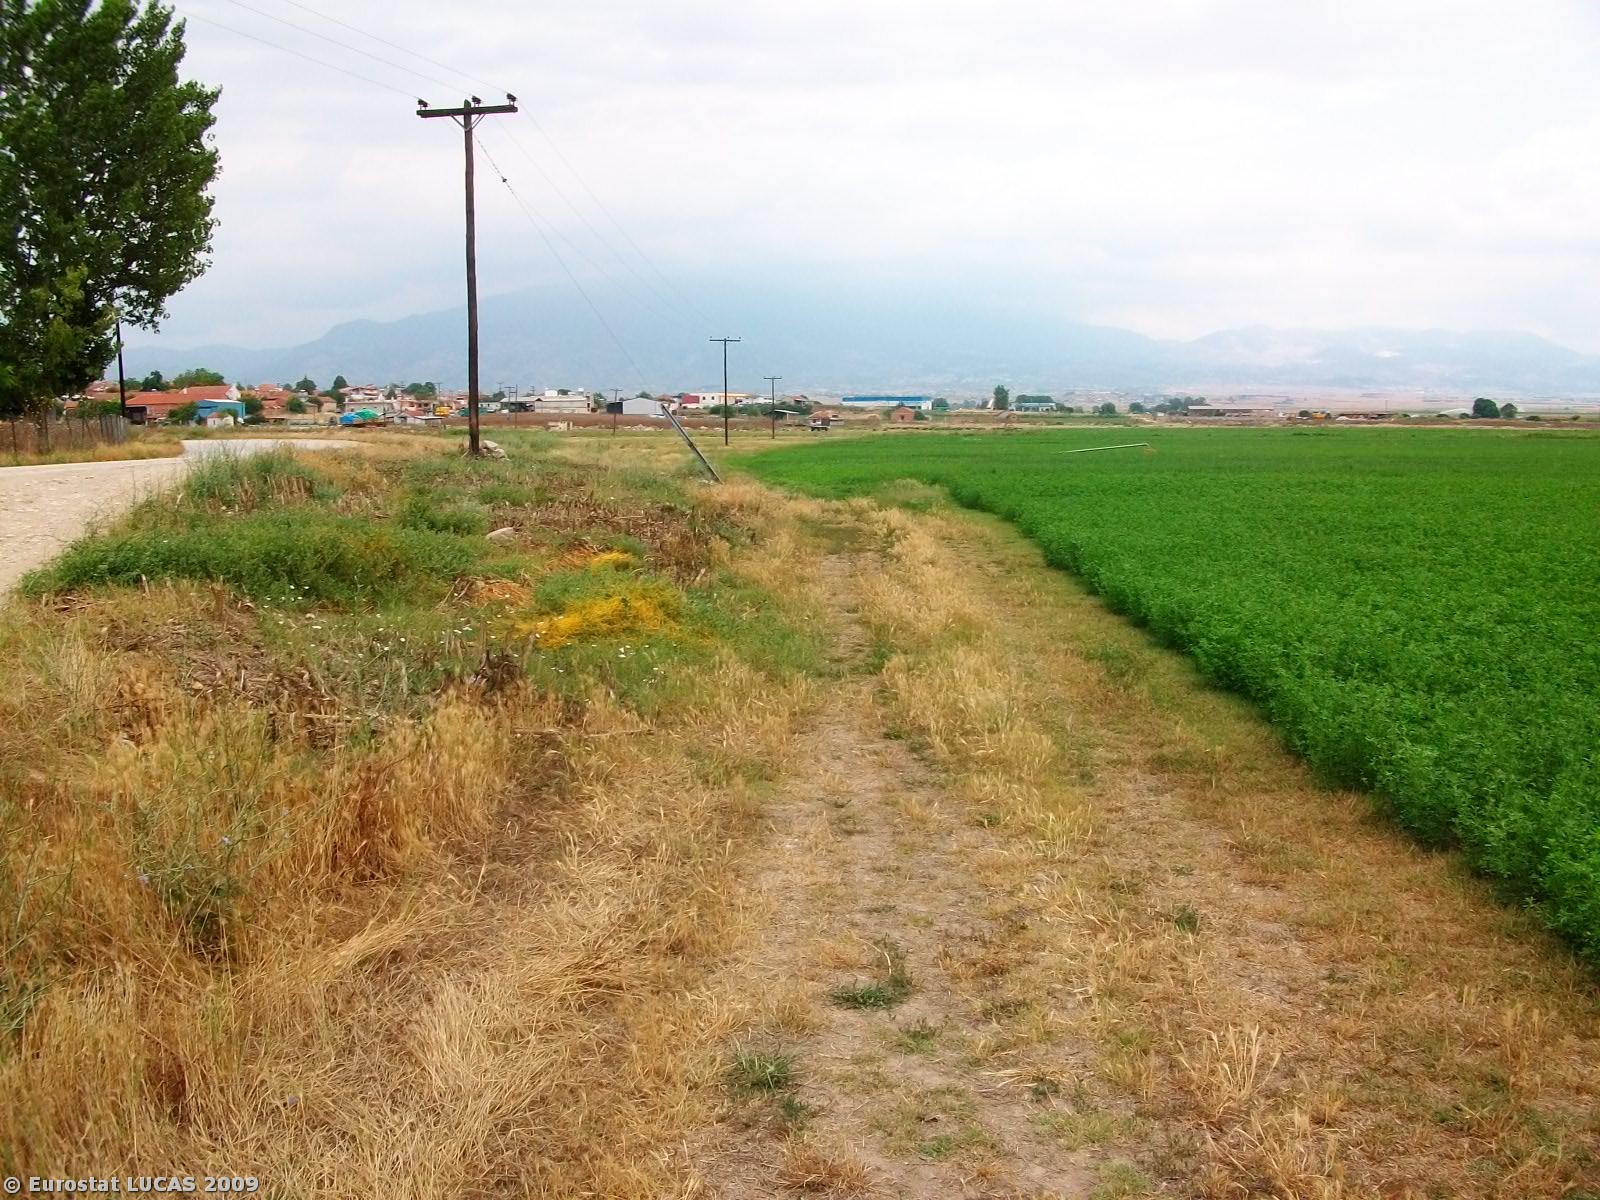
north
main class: Cropland
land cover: Clovers
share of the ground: > 75 %
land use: Agriculture (excluding fallow land and kitchen gardens)
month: June
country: GR
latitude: 41.0167
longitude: 23.6121
